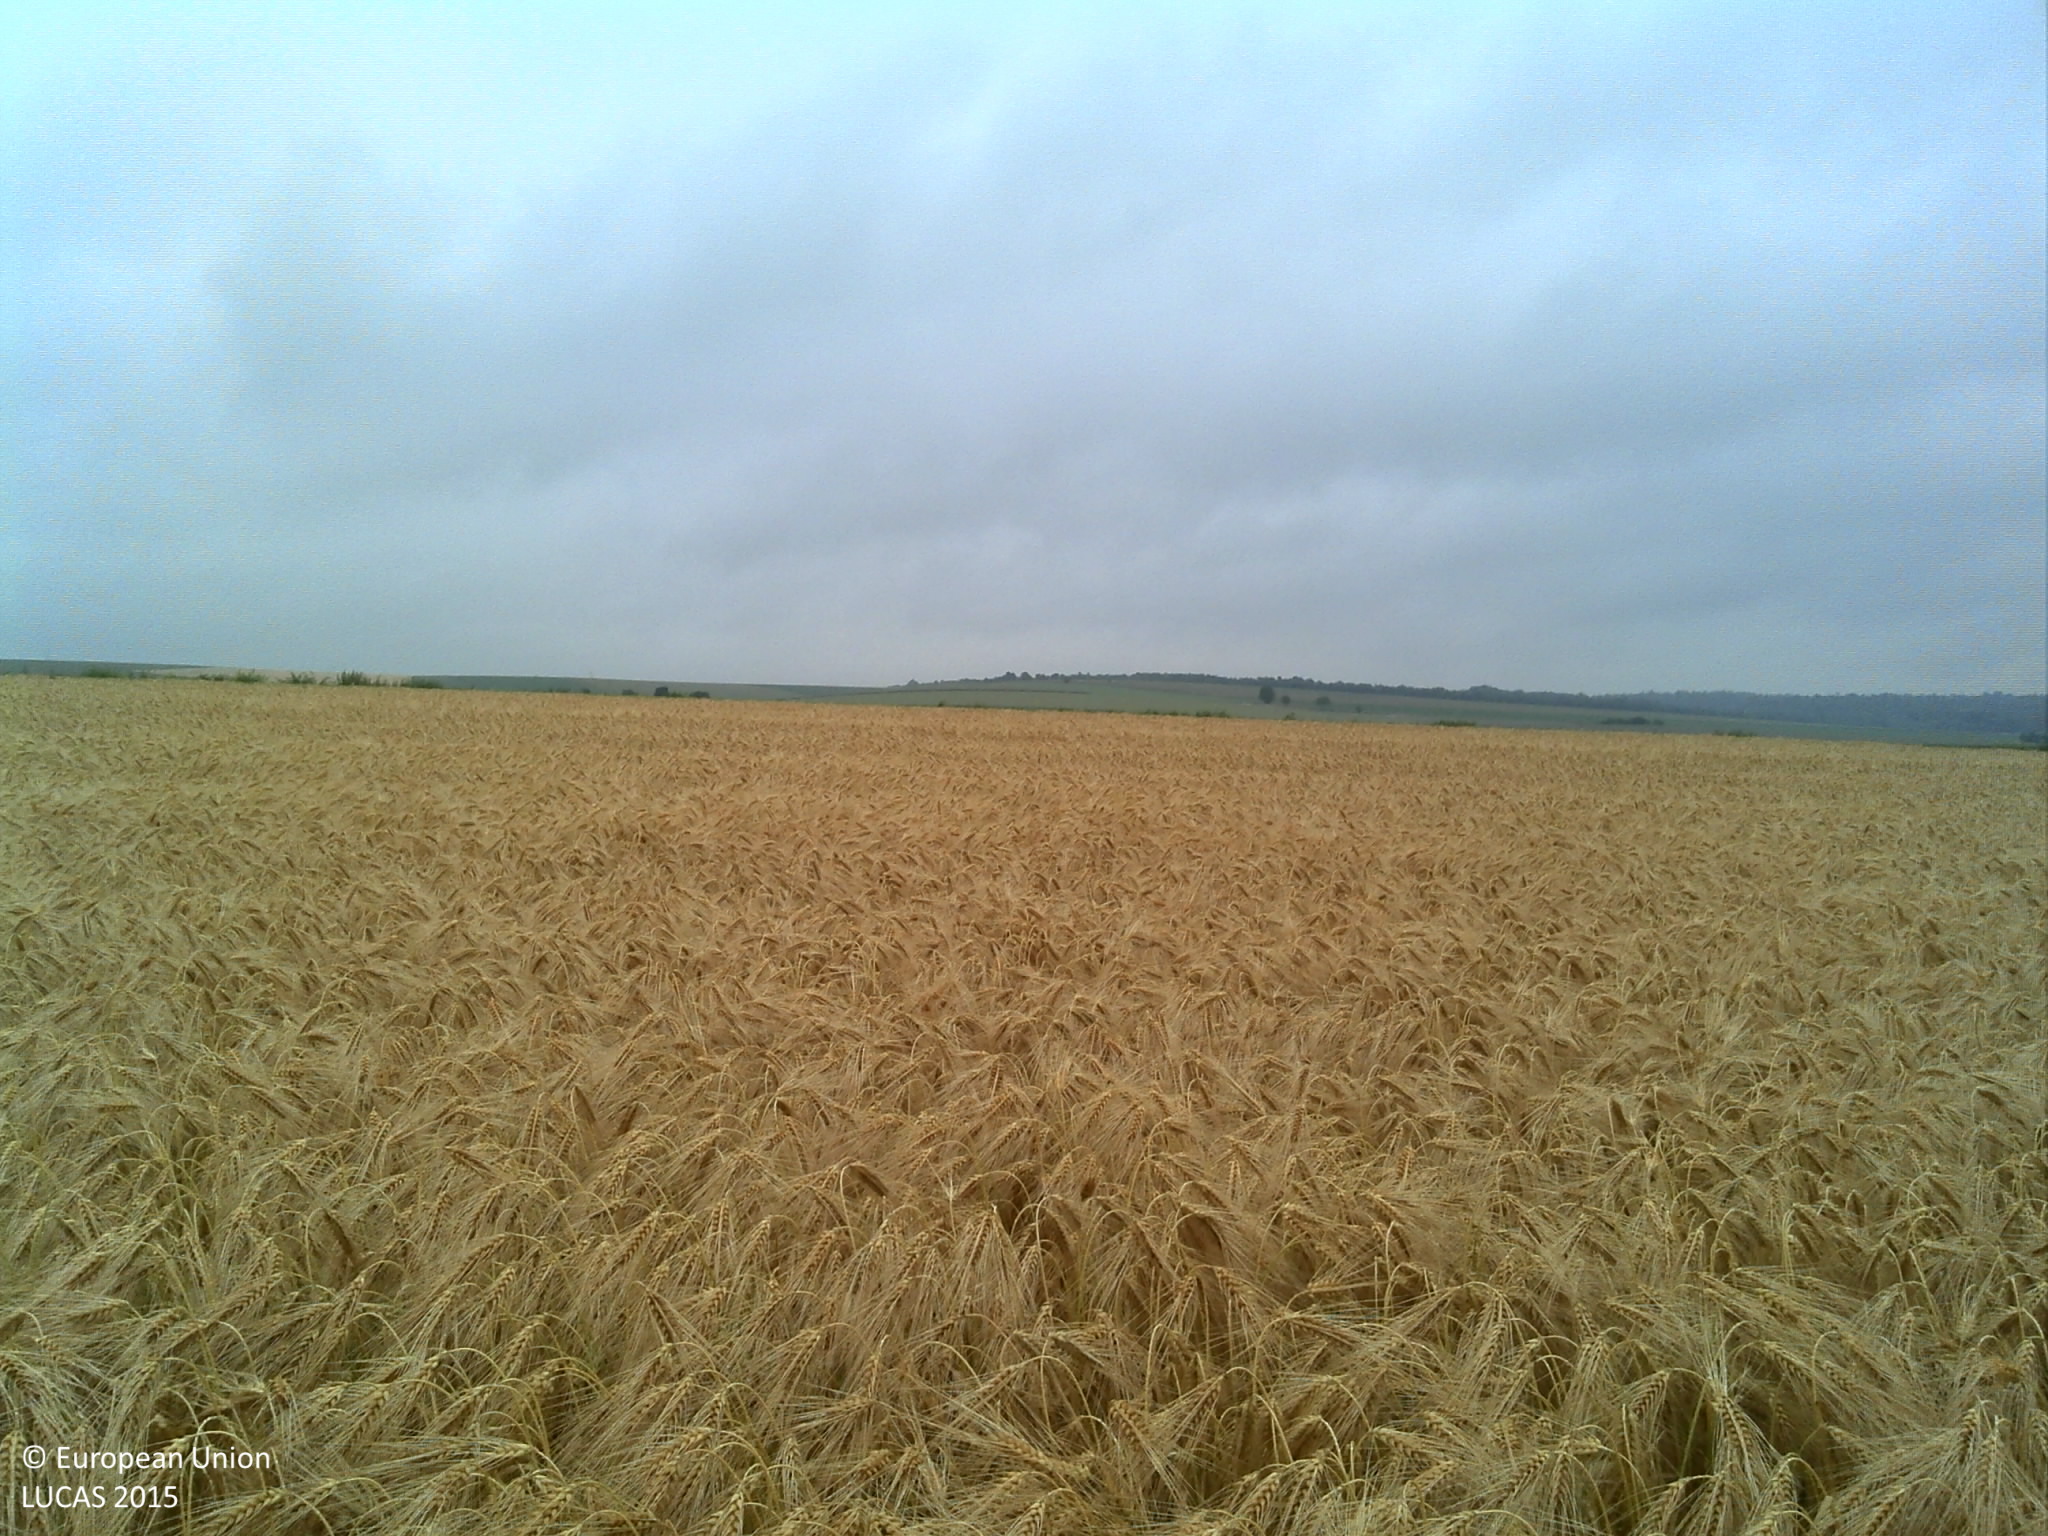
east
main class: Cropland
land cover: Common wheat
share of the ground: > 75 %
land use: Agriculture (excluding fallow land and kitchen gardens)
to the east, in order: Common wheat; Managed hedges; Grass margins; Tracks; Grass margins; Managed hedges; Sugar beet
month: June
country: FR
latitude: 48.6868
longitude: 4.2504
